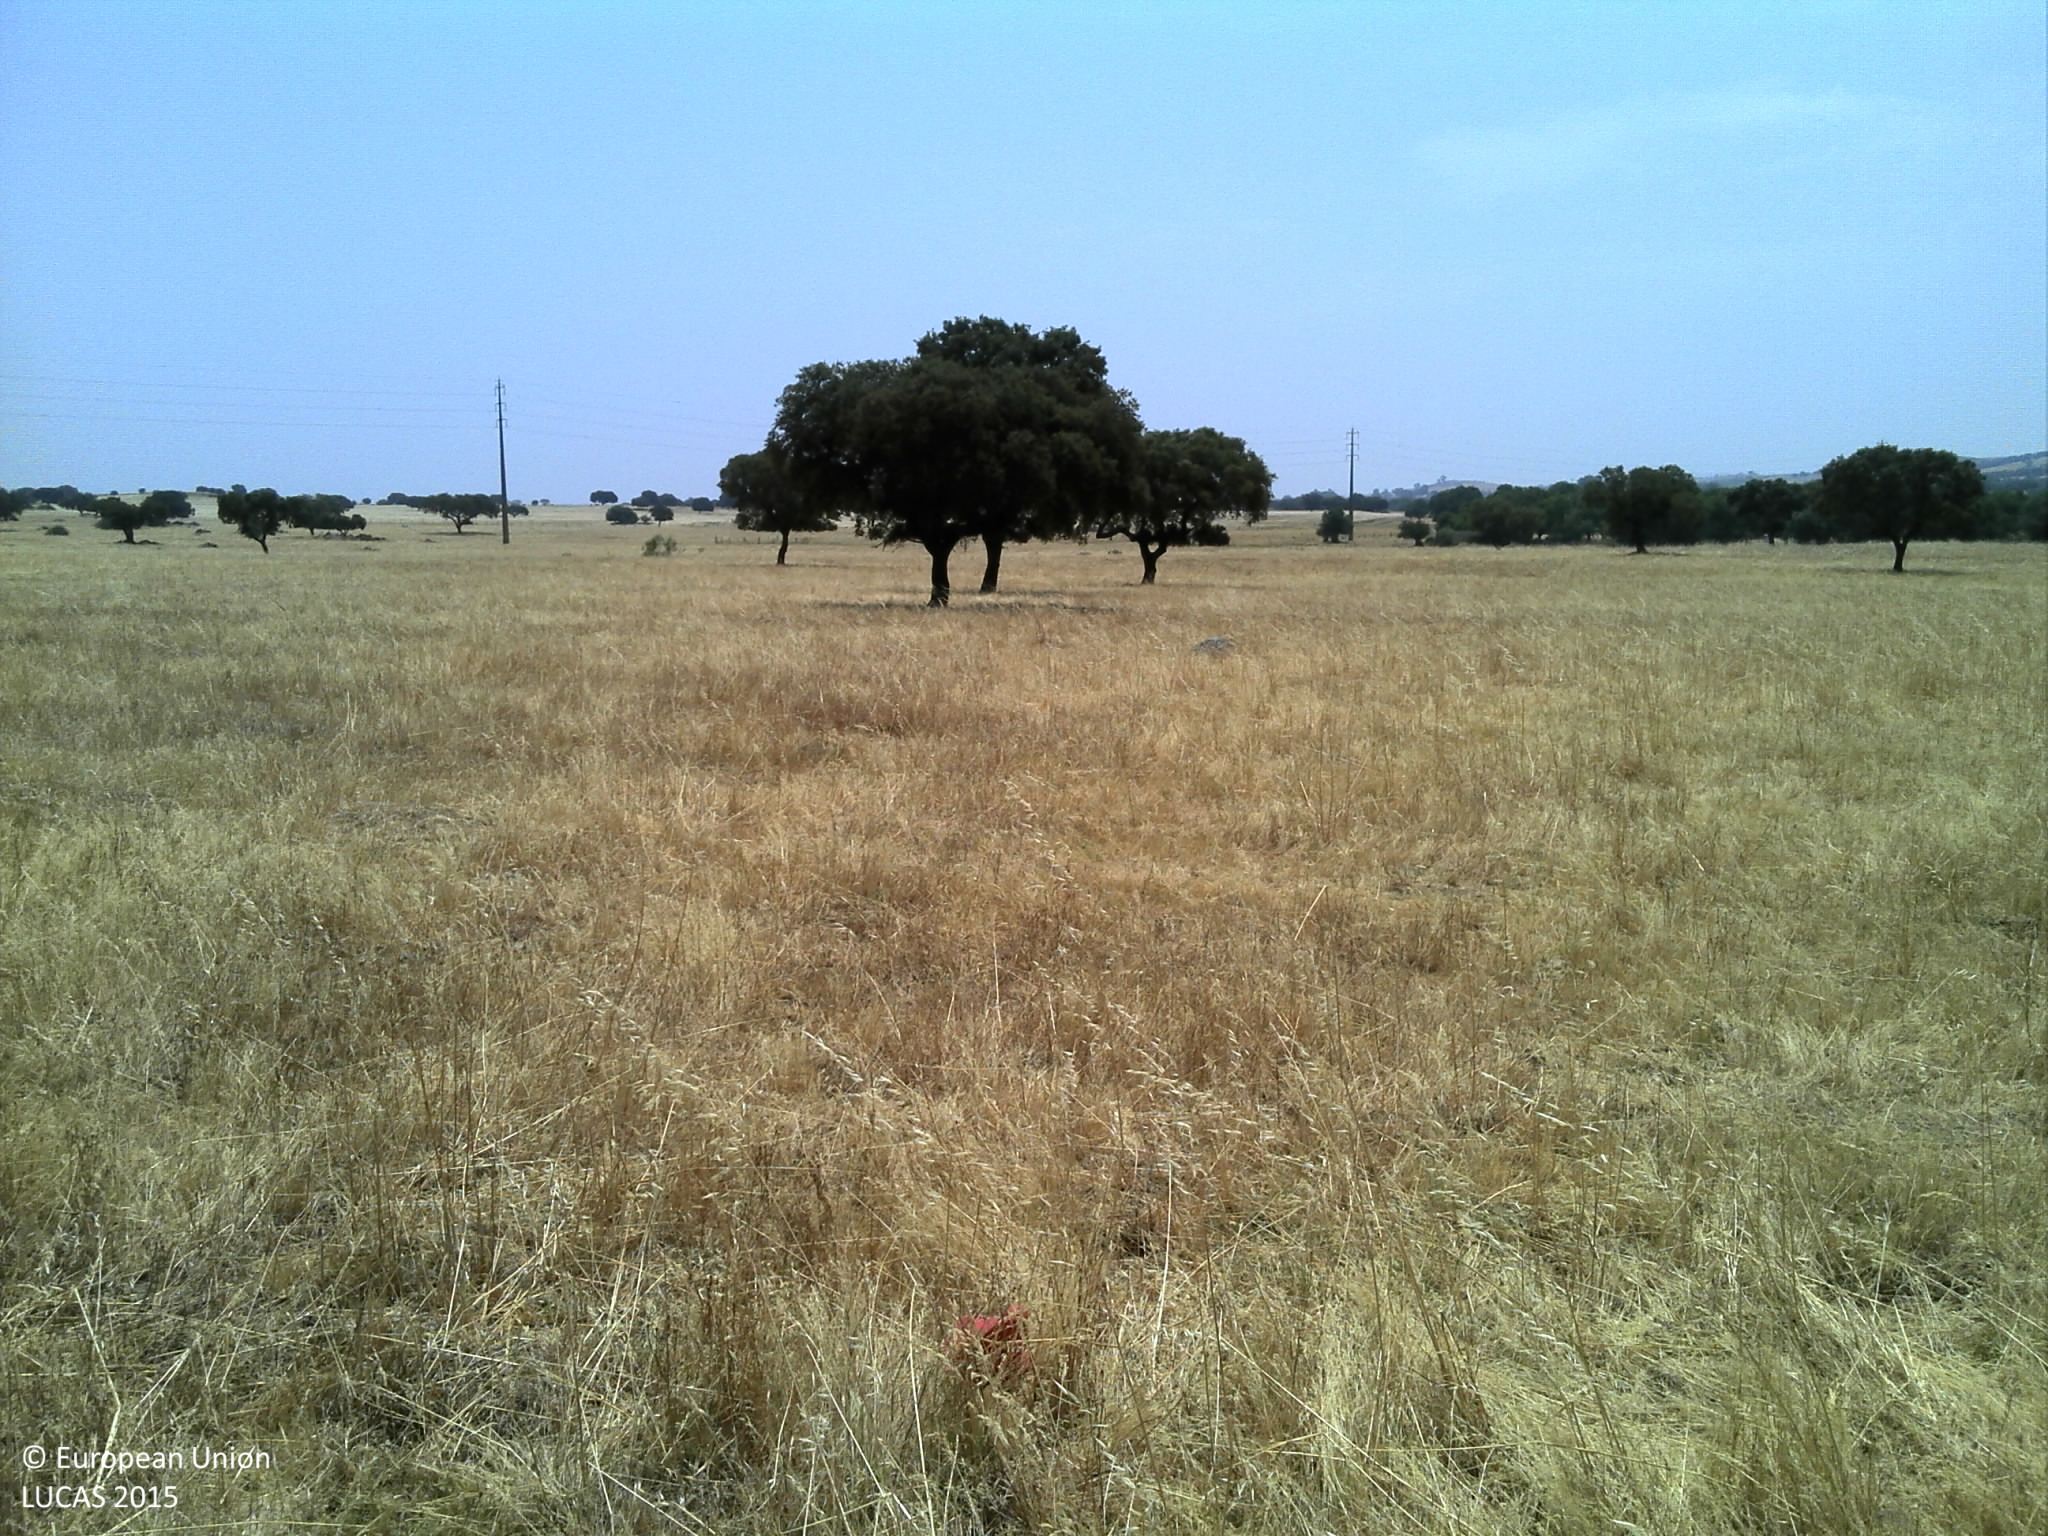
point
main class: Grassland
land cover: Grassland without tree/shrub cover
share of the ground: 50 - 75 %
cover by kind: herbaceous plants 60 %, unconsolidated bare surface 40 %
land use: Agriculture (excluding fallow land and kitchen gardens)
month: June
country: PT
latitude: 38.4744
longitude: -7.8134
